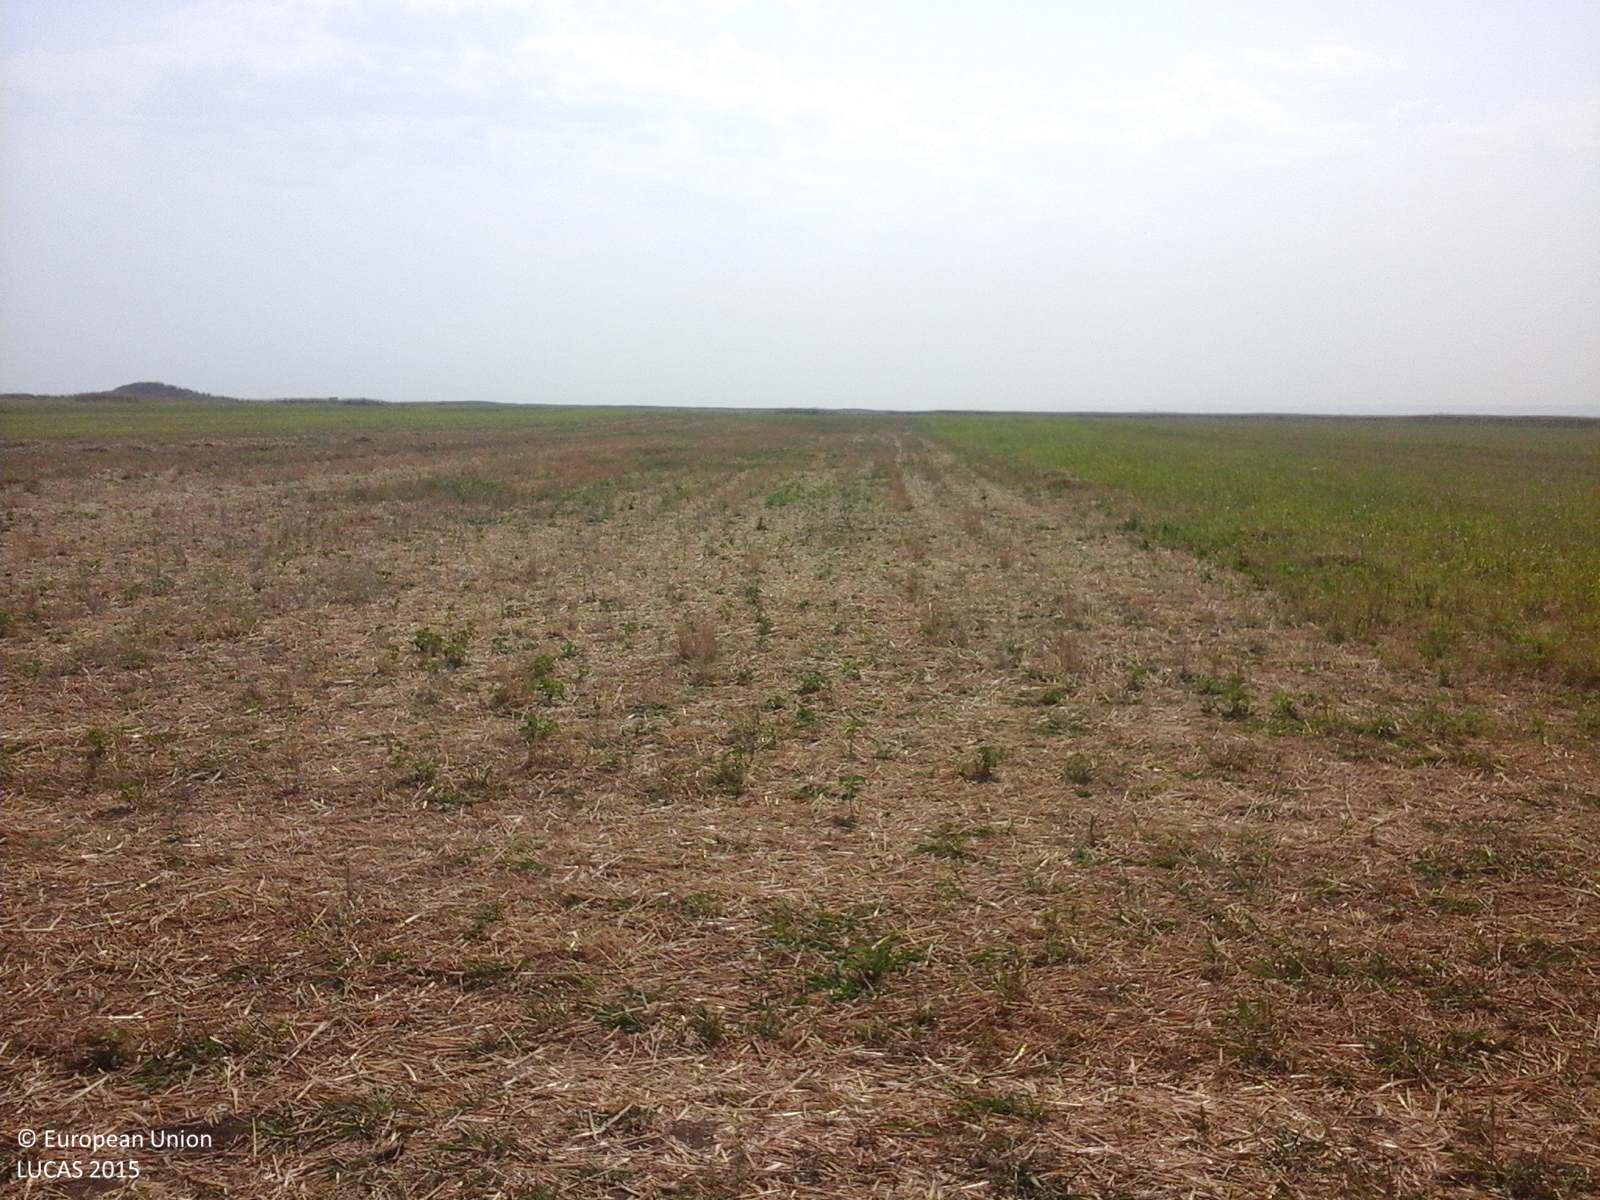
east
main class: Cropland
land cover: Sunflower
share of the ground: > 75 %
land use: Agriculture (excluding fallow land and kitchen gardens)
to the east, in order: Sunflower
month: August
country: RO
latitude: 43.9188
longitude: 23.2329
